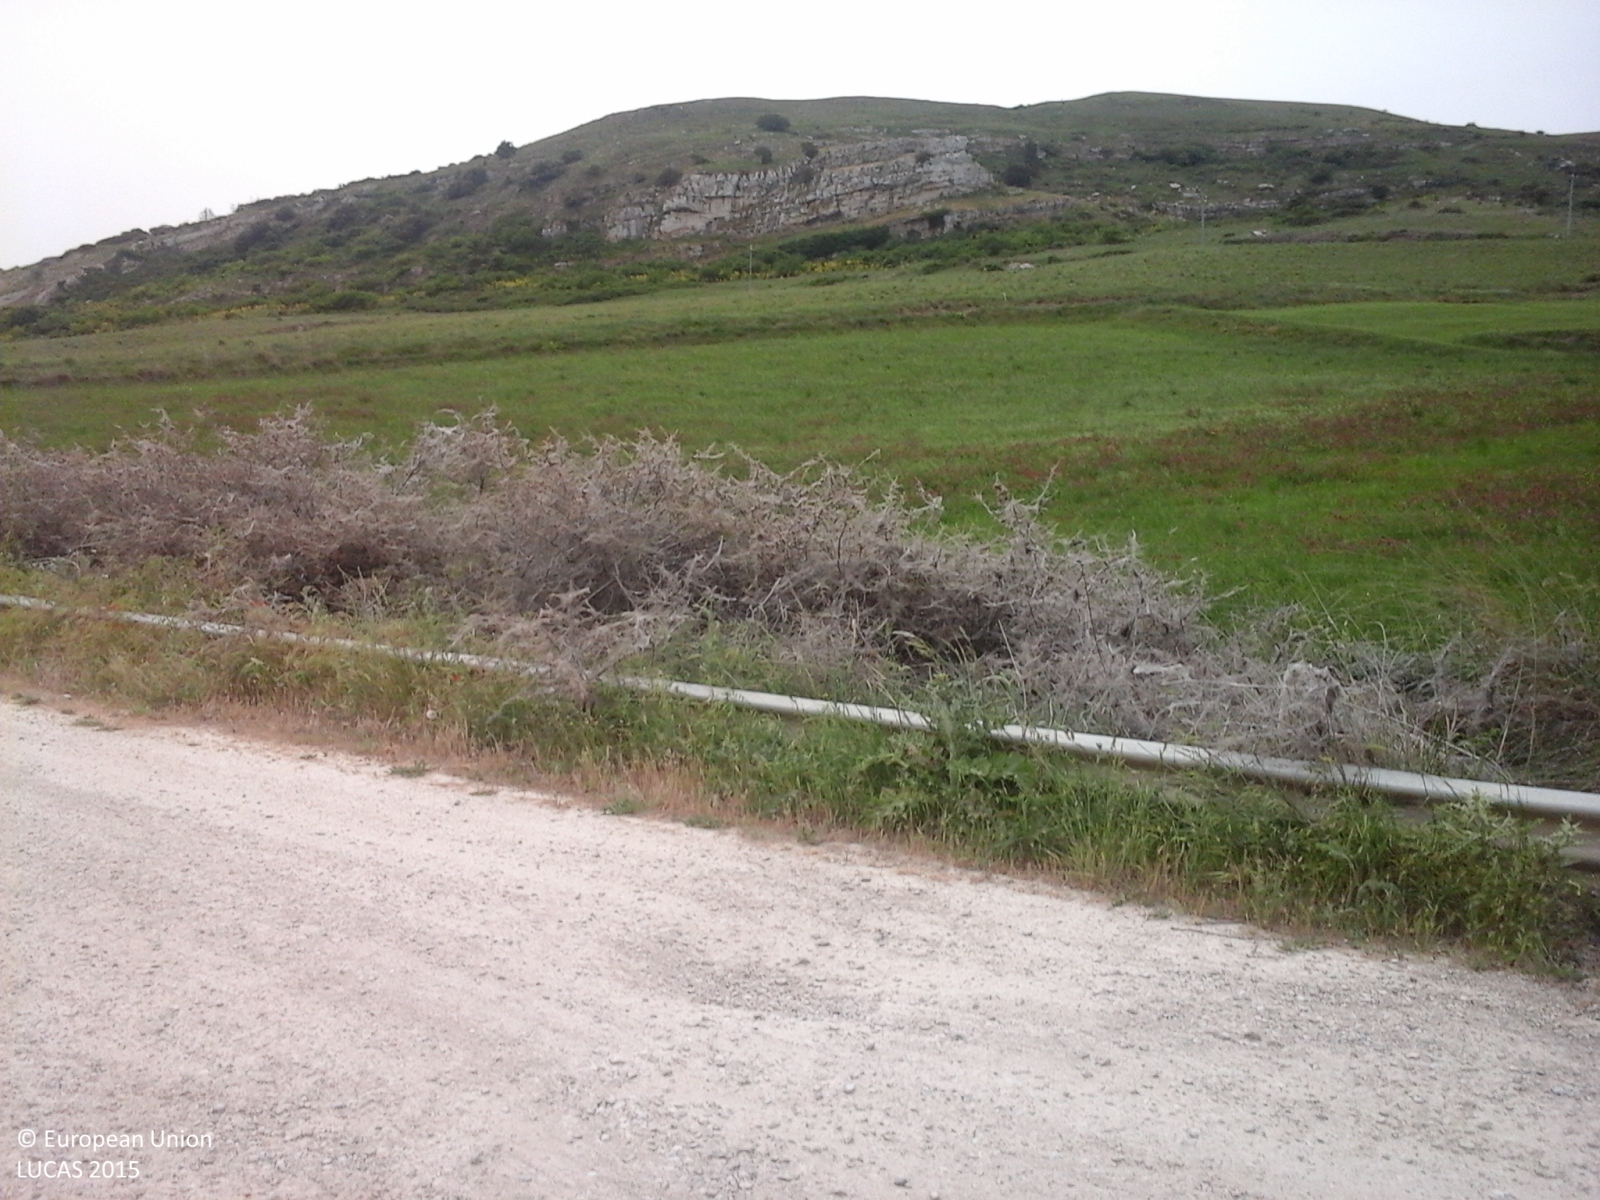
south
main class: Cropland
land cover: Durum wheat
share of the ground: > 75 %
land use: Agriculture (excluding fallow land and kitchen gardens)
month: May
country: IT
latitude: 37.7177
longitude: 13.5474
